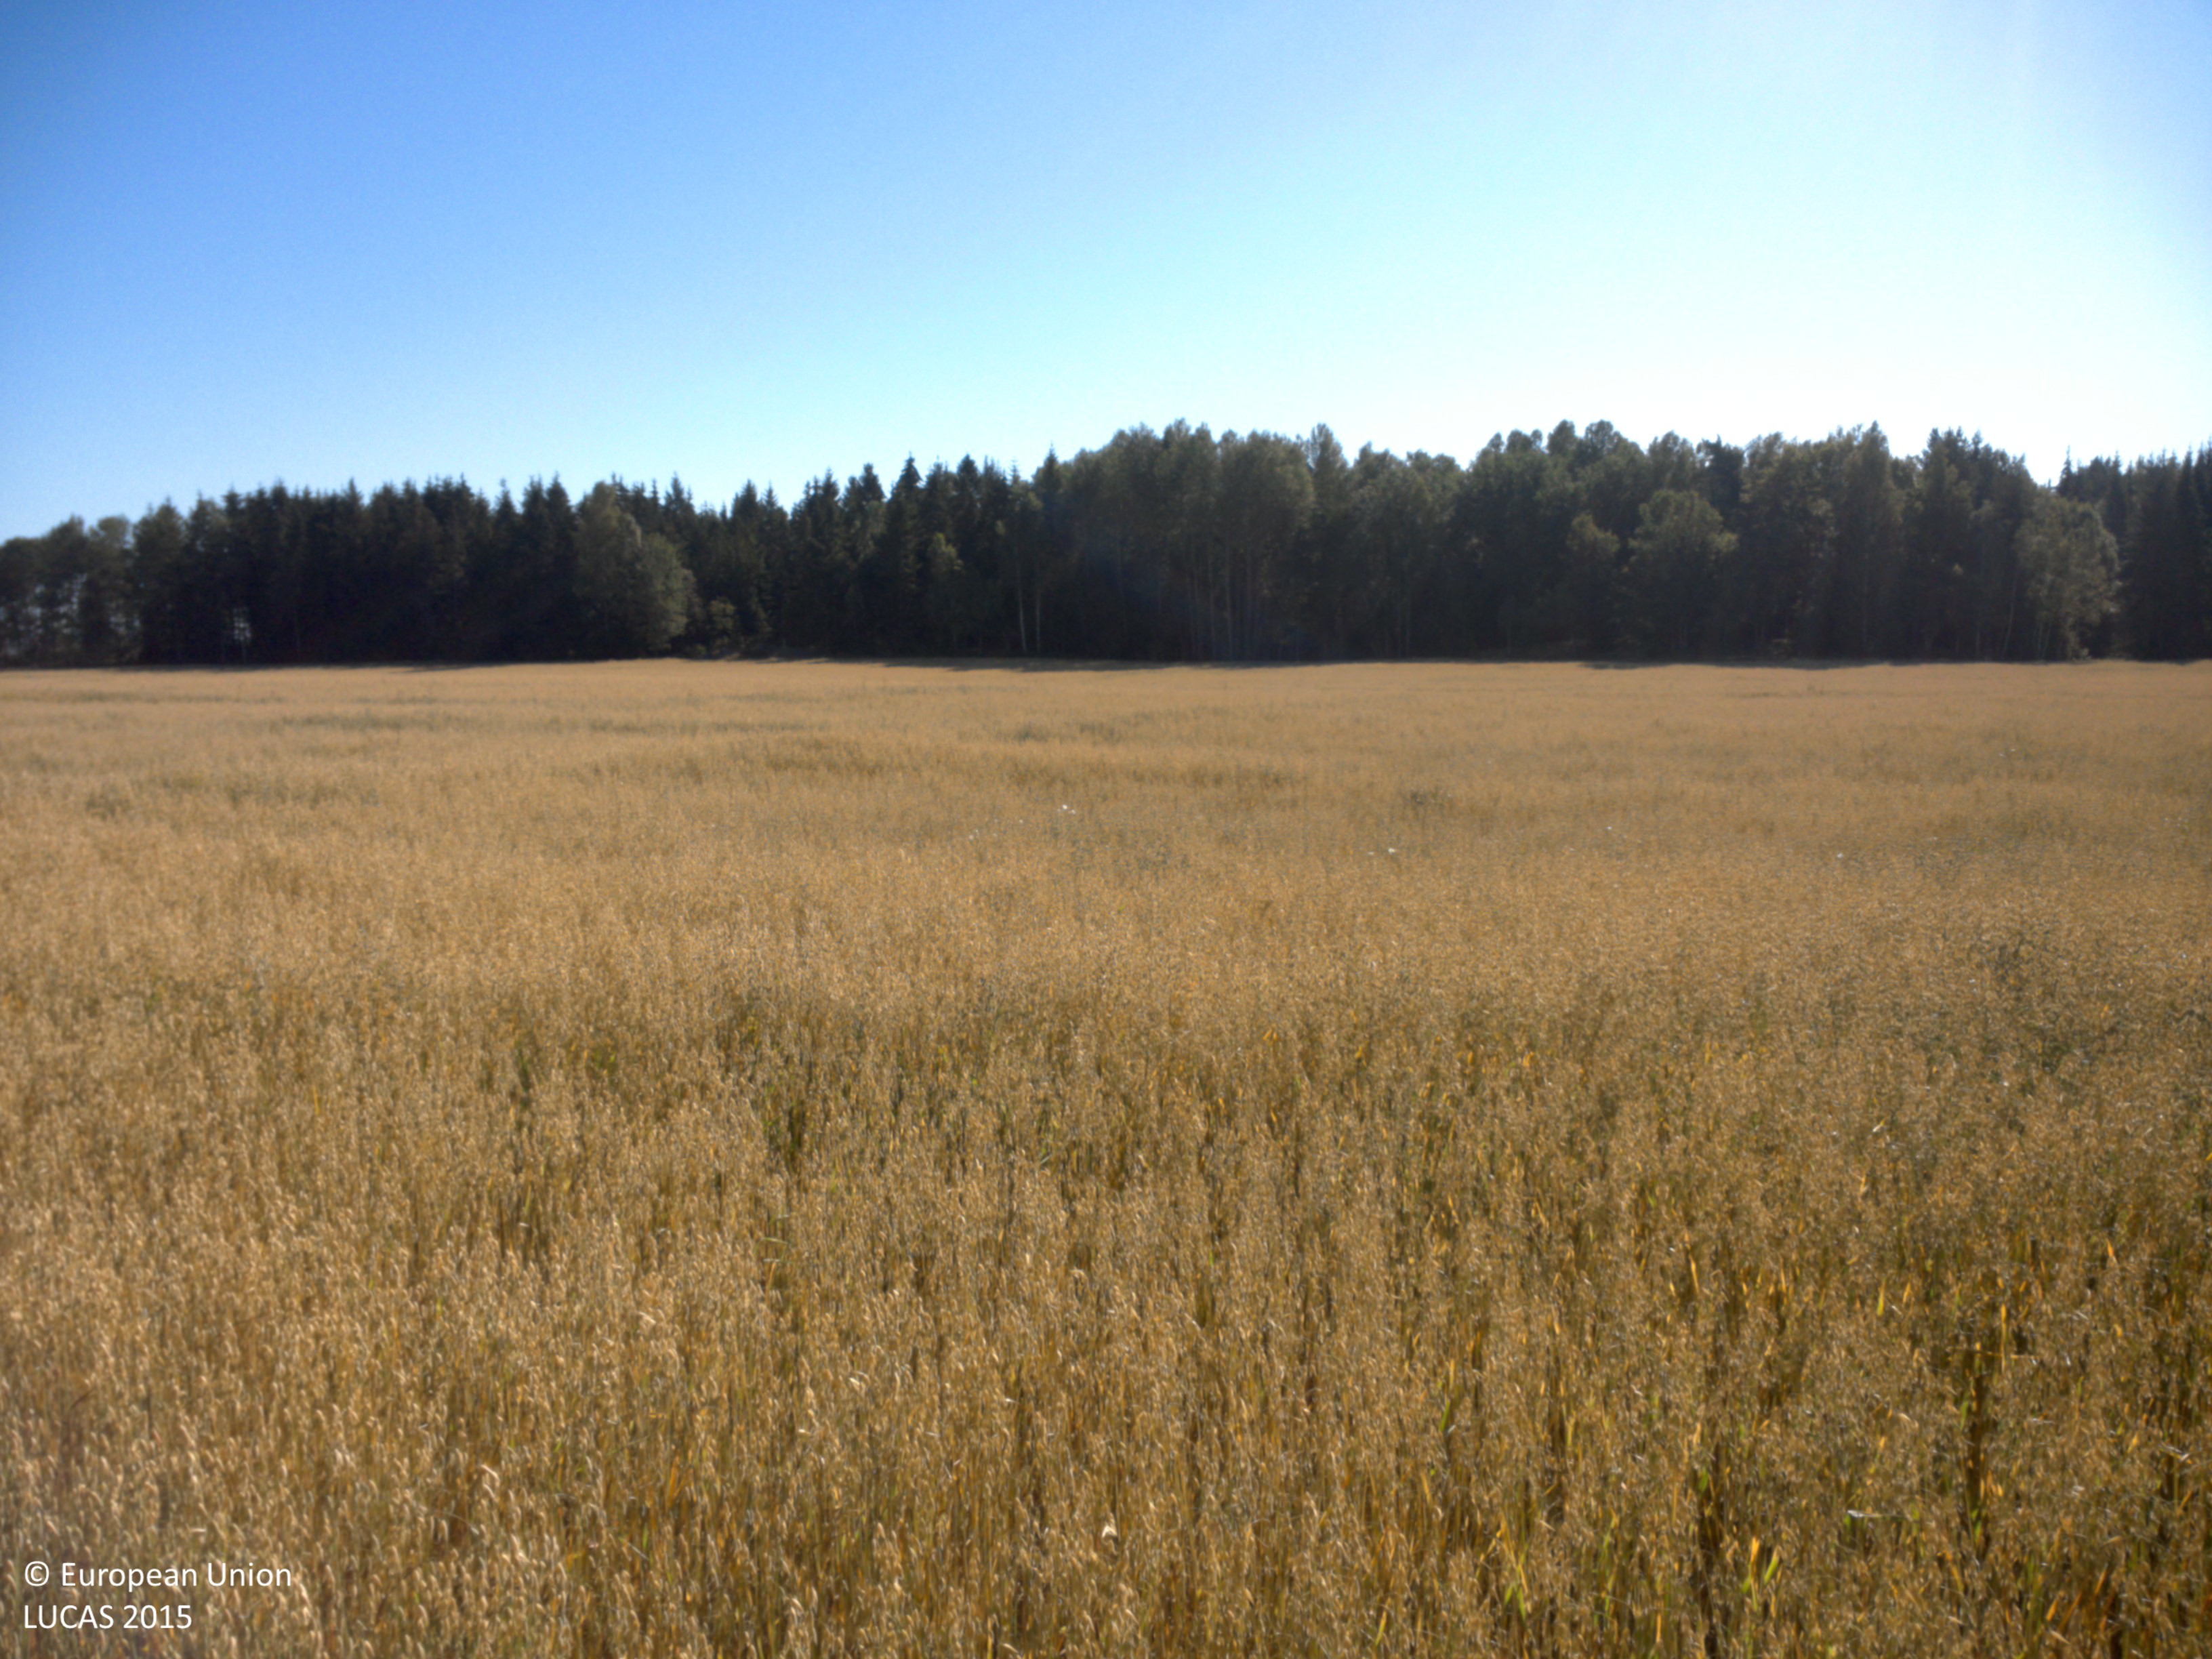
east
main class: Cropland
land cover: Oats
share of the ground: > 75 %
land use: Agriculture (excluding fallow land and kitchen gardens)
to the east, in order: Oats; Tracks; Spruce dominated coniferous woodland
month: August
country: SE
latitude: 58.6134
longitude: 12.3192
